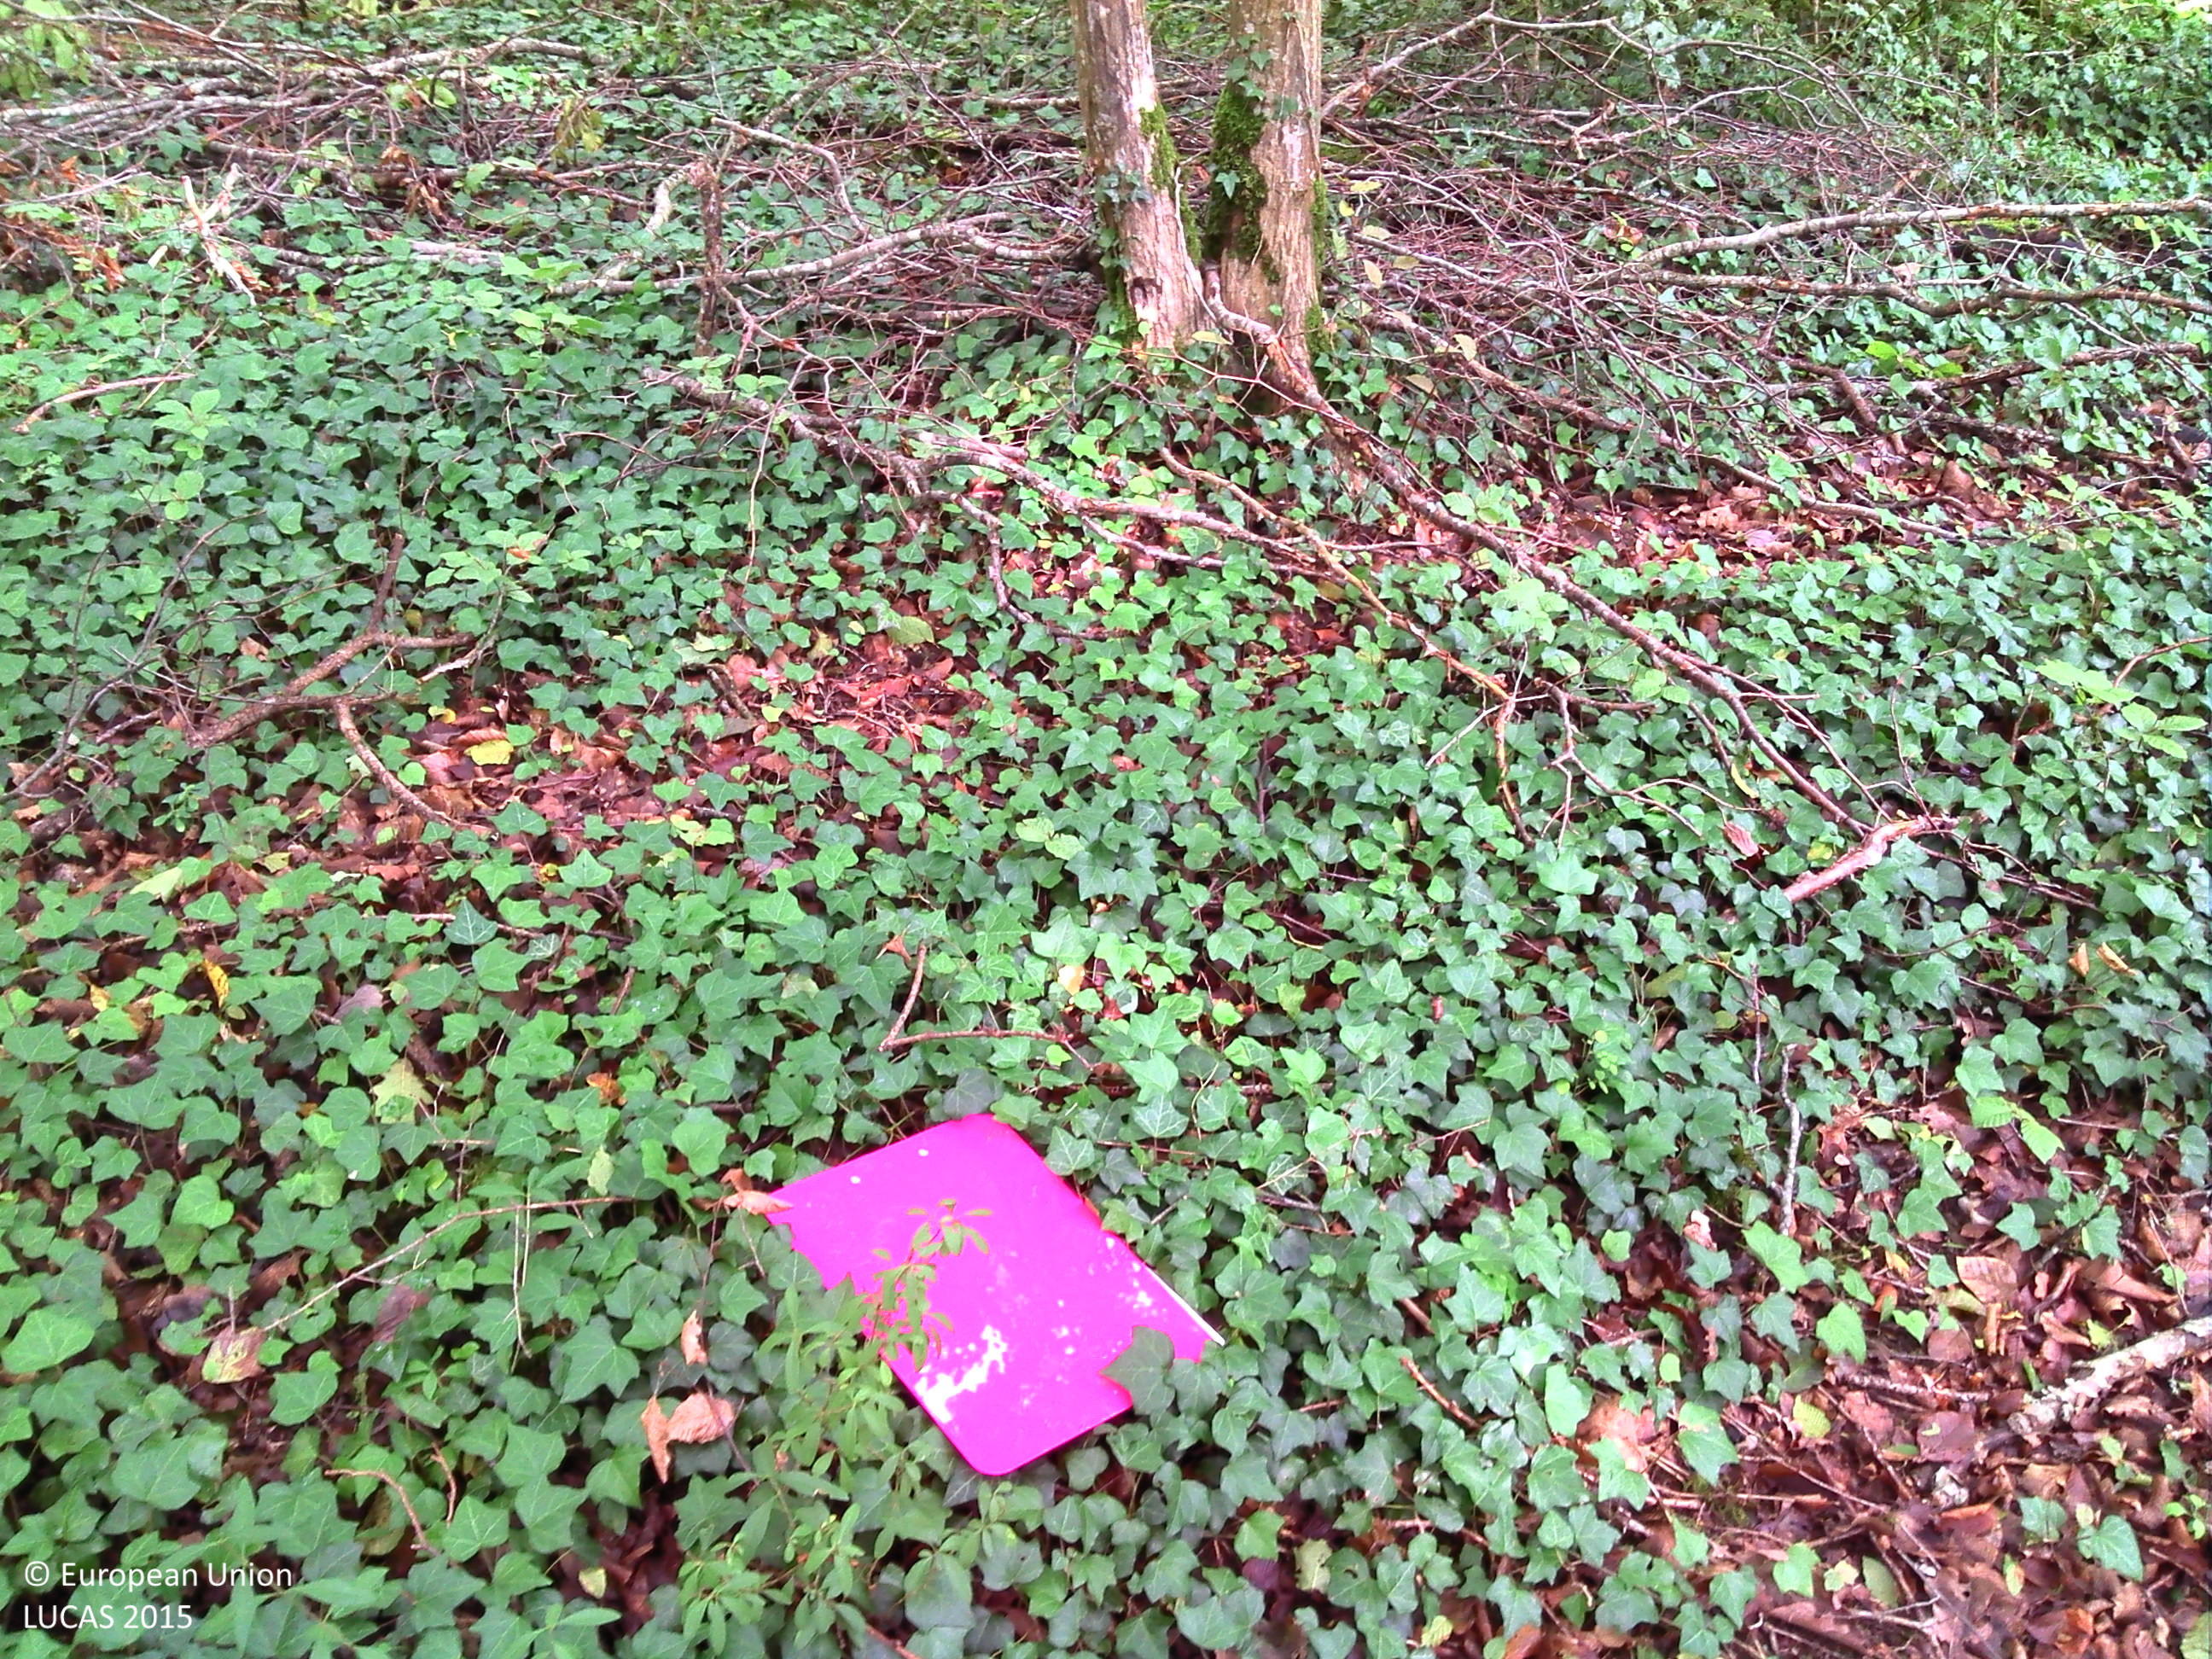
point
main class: Woodland
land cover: Broadleaved woodland
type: mesophytic deciduous forest
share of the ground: > 75 %
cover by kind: broadleaved forest trees 80 %, herbaceous plants 10 %, shrubs 5 %, lichens and mosses 5 %
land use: Forestry
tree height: > 5 m
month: September
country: FR
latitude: 48.2996
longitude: 4.8082
